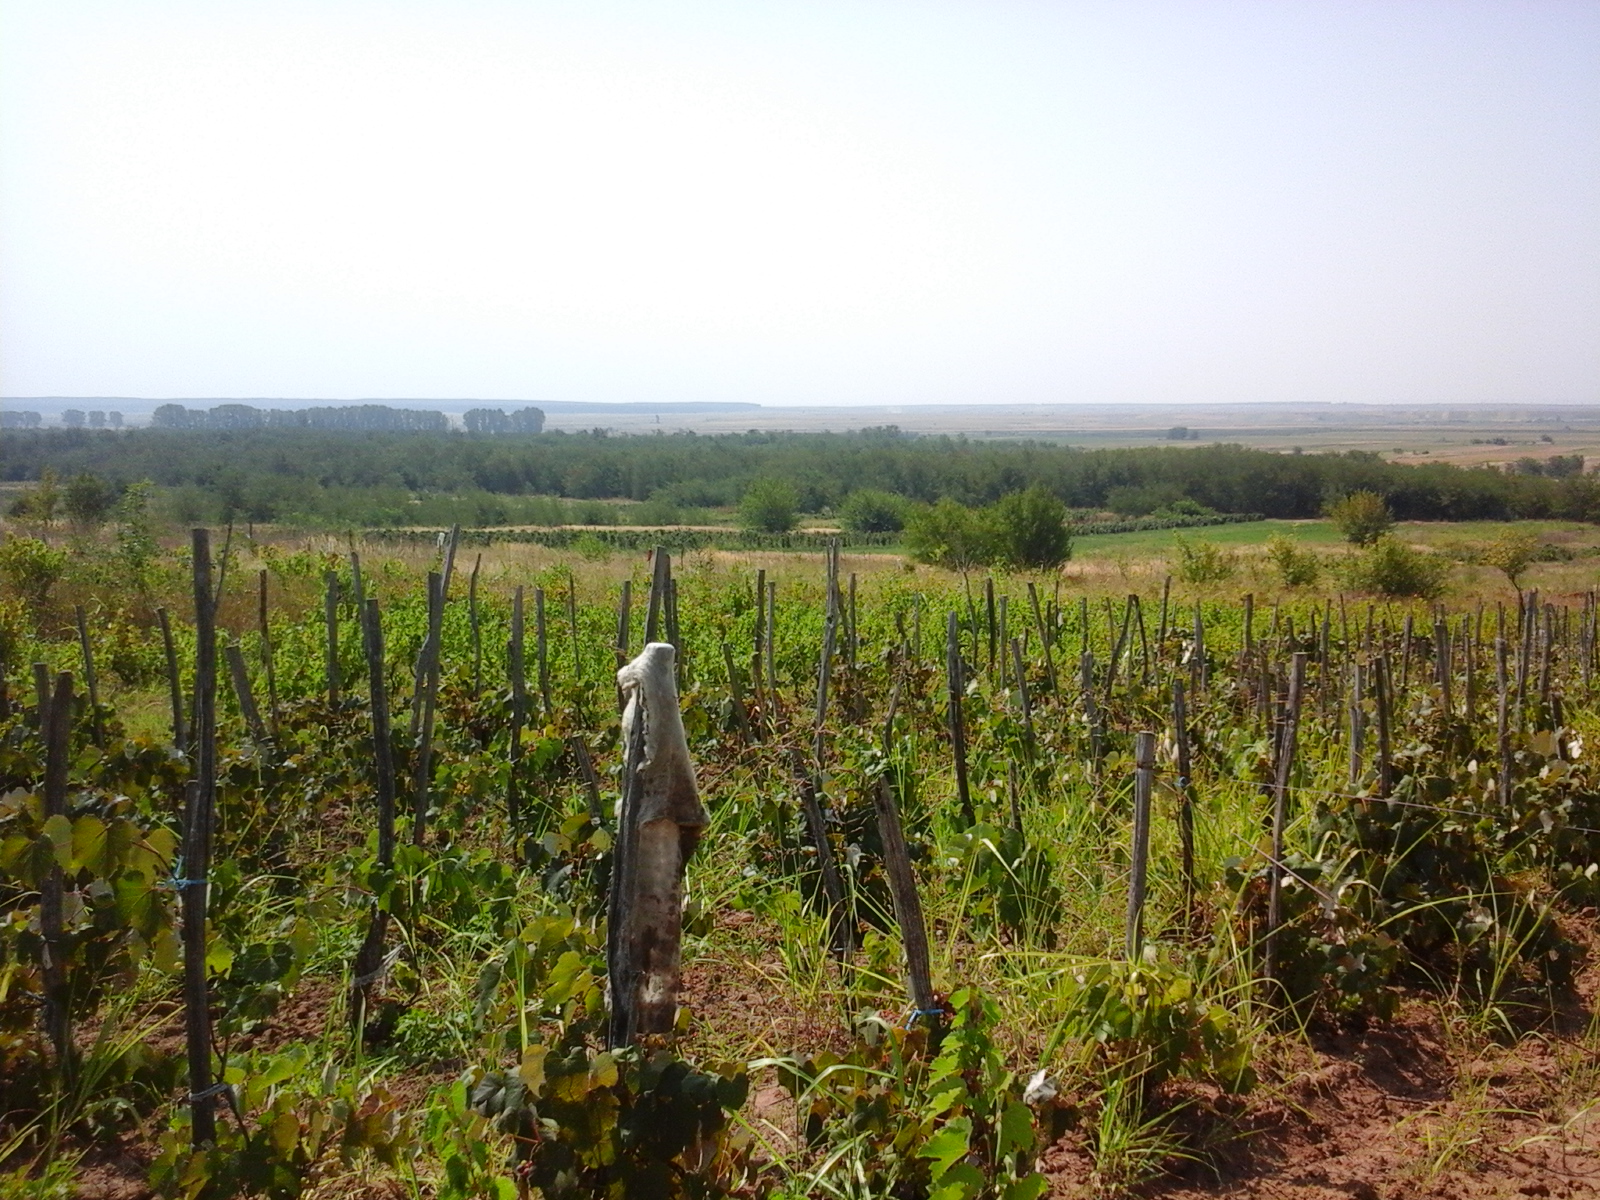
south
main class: Cropland
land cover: Vineyards
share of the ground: > 75 %
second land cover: Spontaneously vegetated surfaces
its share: > 75 %
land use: Agriculture (excluding fallow land and kitchen gardens)
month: August
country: RO
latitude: 44.3690
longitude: 22.7020
